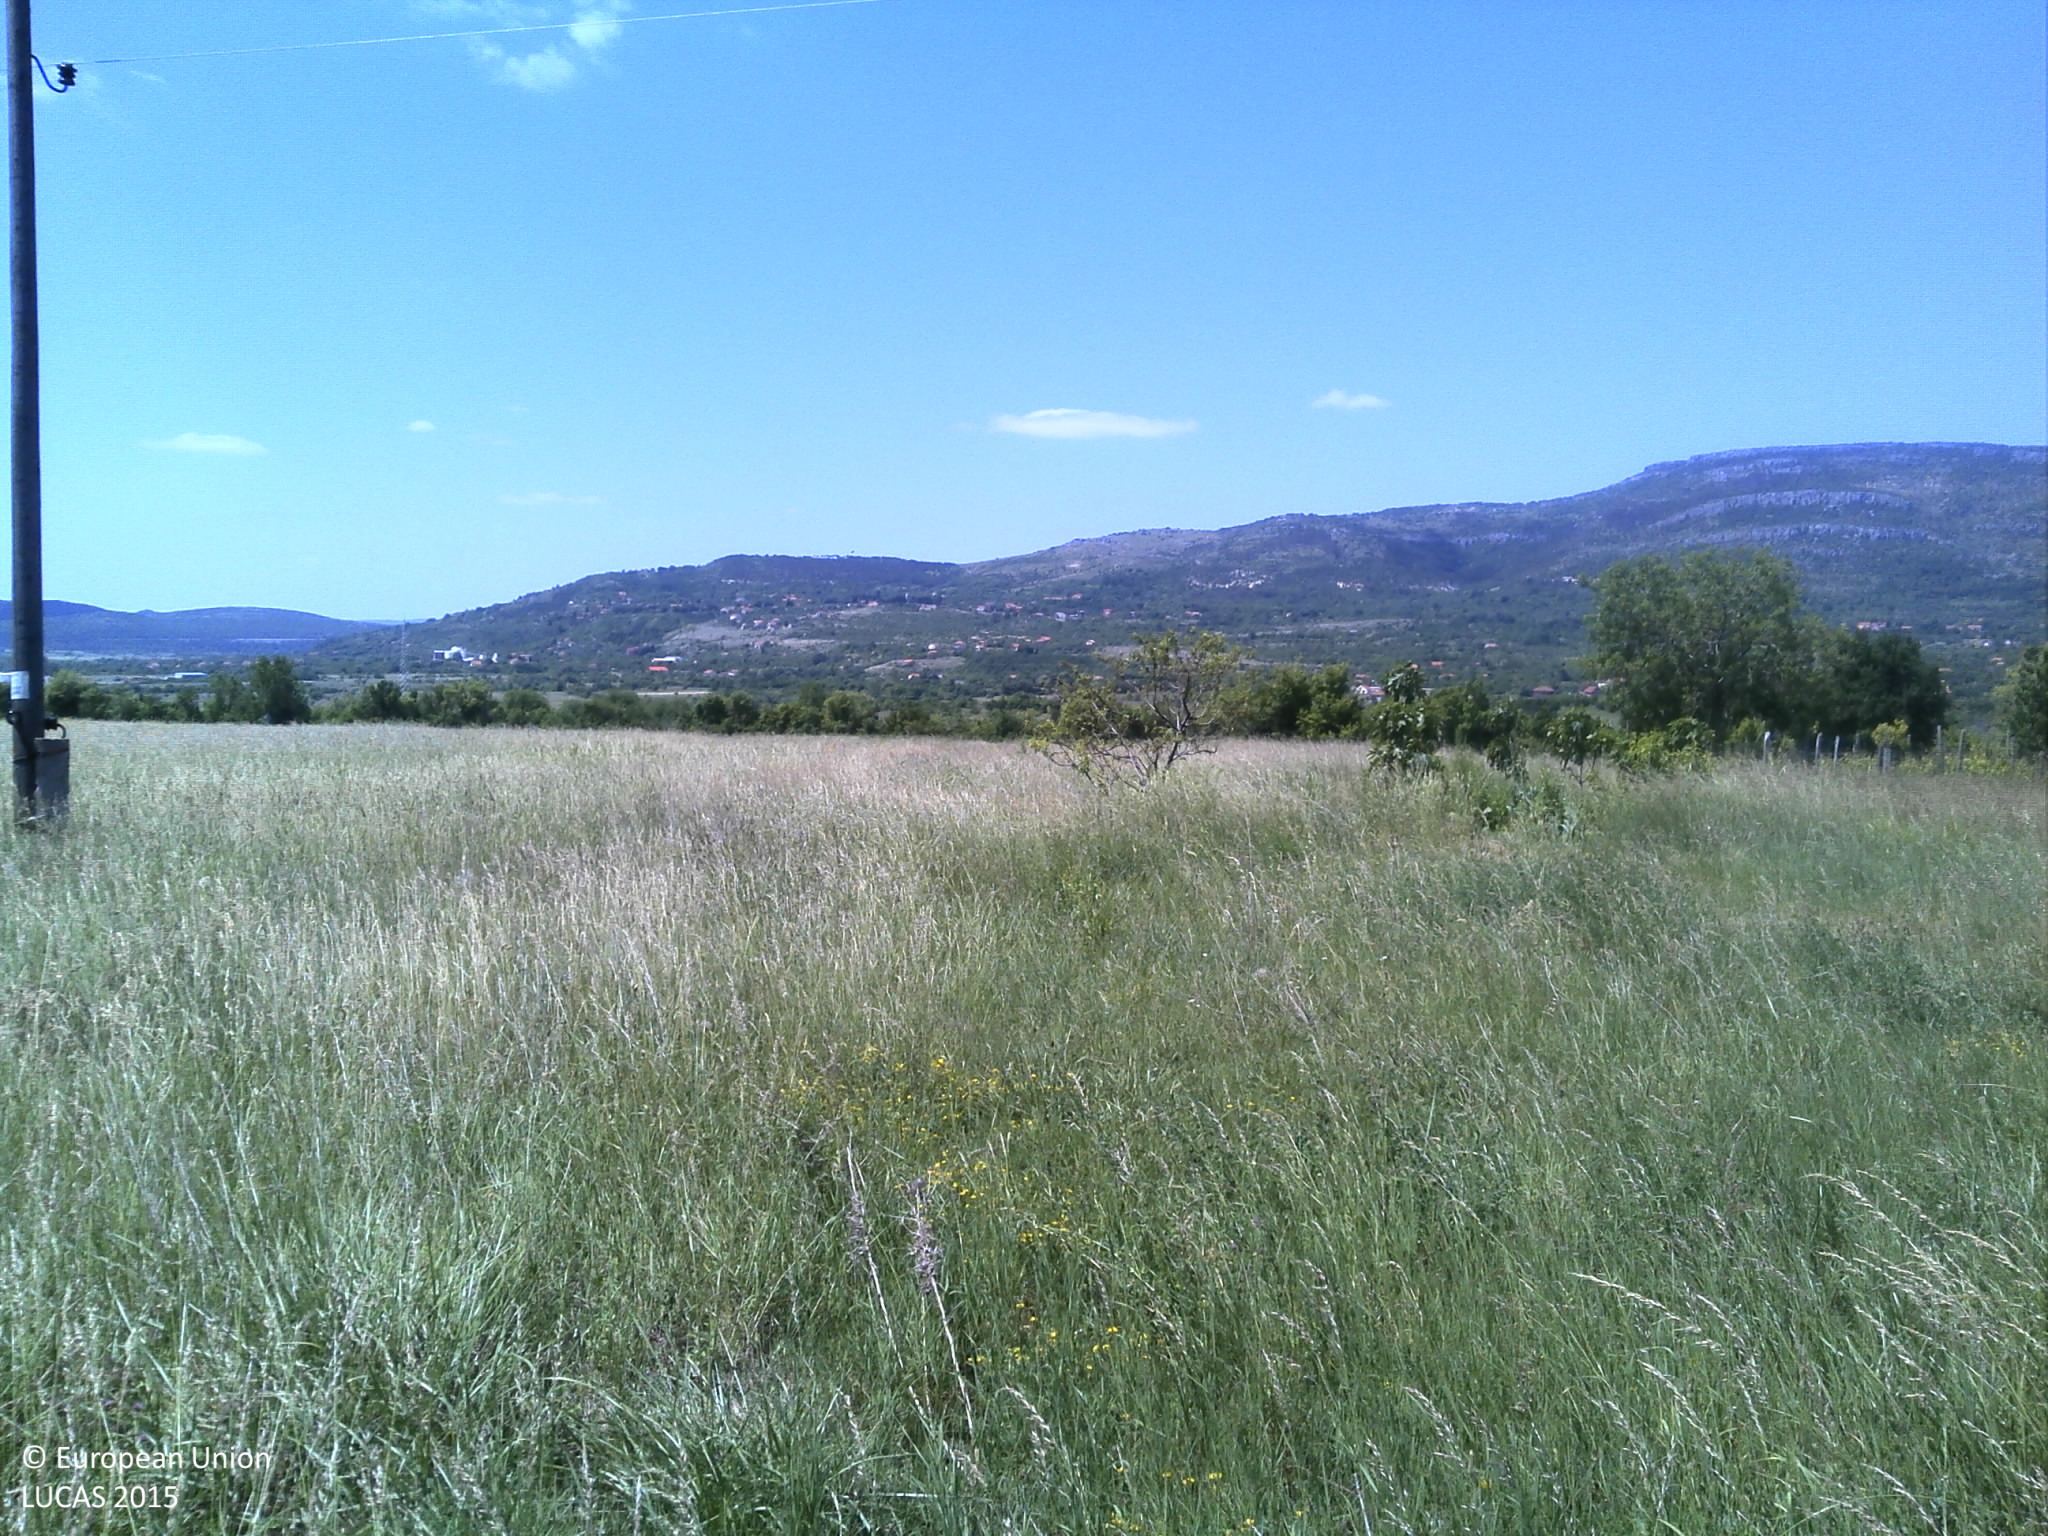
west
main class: Grassland
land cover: Grassland without tree/shrub cover
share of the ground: > 75 %
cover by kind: herbaceous plants 100 %
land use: Agriculture (excluding fallow land and kitchen gardens)
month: May
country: HR
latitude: 43.8921
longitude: 16.2286
